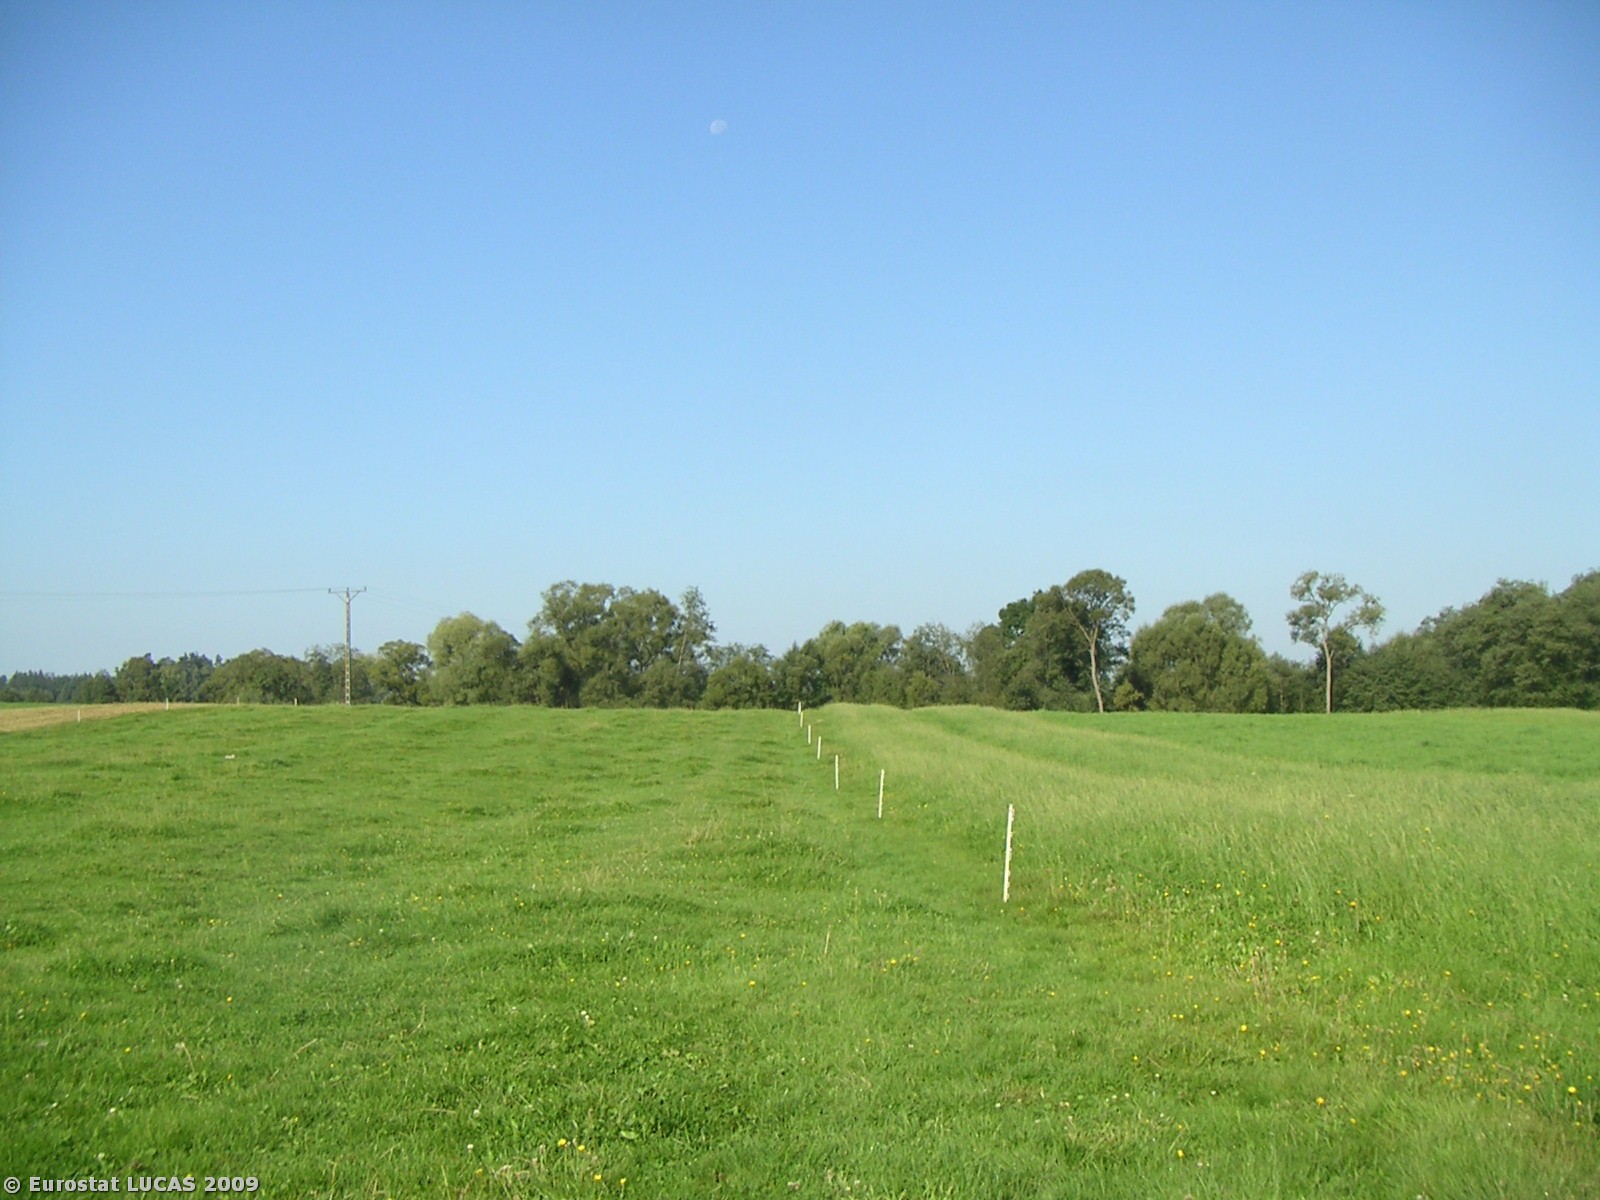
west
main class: Grassland
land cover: Grassland without tree/shrub cover
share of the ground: > 75 %
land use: Agriculture (excluding fallow land and kitchen gardens)
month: September
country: PL
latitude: 49.4457
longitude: 20.0872
